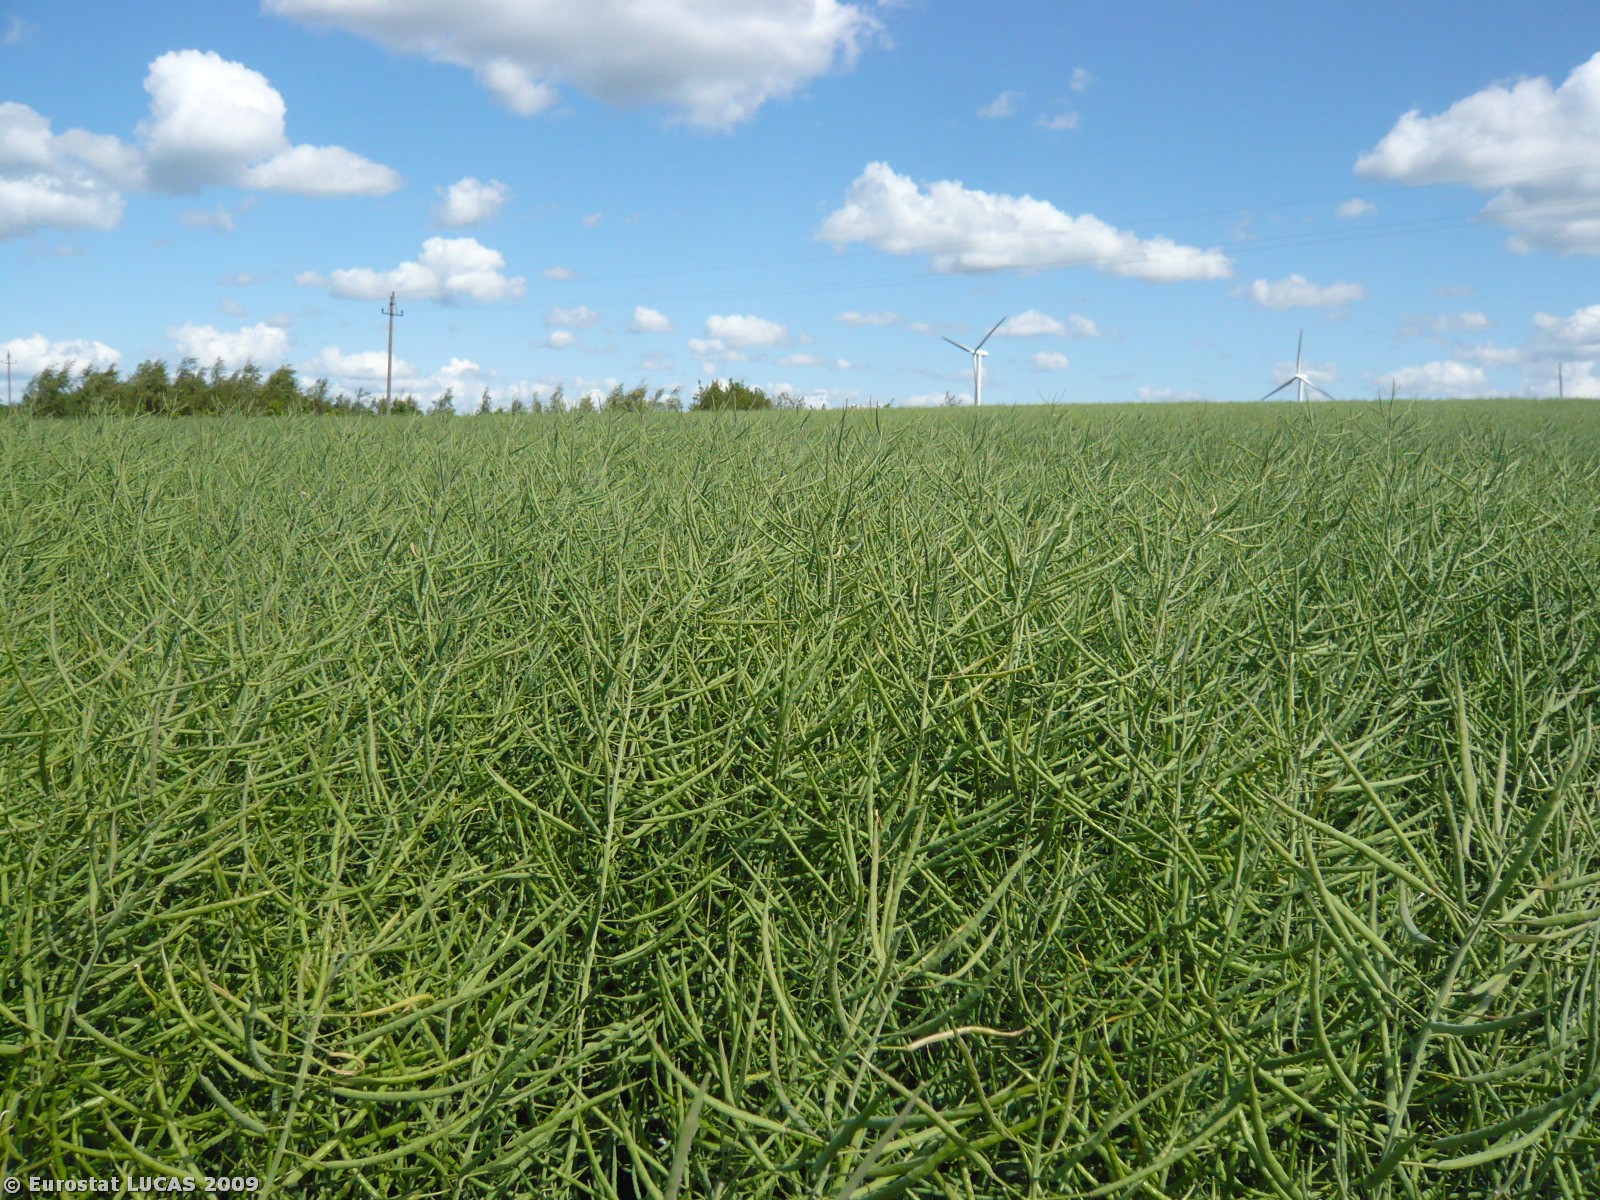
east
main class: Cropland
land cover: Rape and turnip rape
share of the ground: > 75 %
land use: Agriculture (excluding fallow land and kitchen gardens)
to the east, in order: Rape and turnip rape; Electric lines; Shrubland with sparse tree cover; Maize; Broadleaved woodland; Rape and turnip rape; Tracks; Artificial constructions; Grassland without tree/shrub cover; Tracks; Temporary grasslands
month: June
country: DK
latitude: 55.3179
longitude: 11.3383
